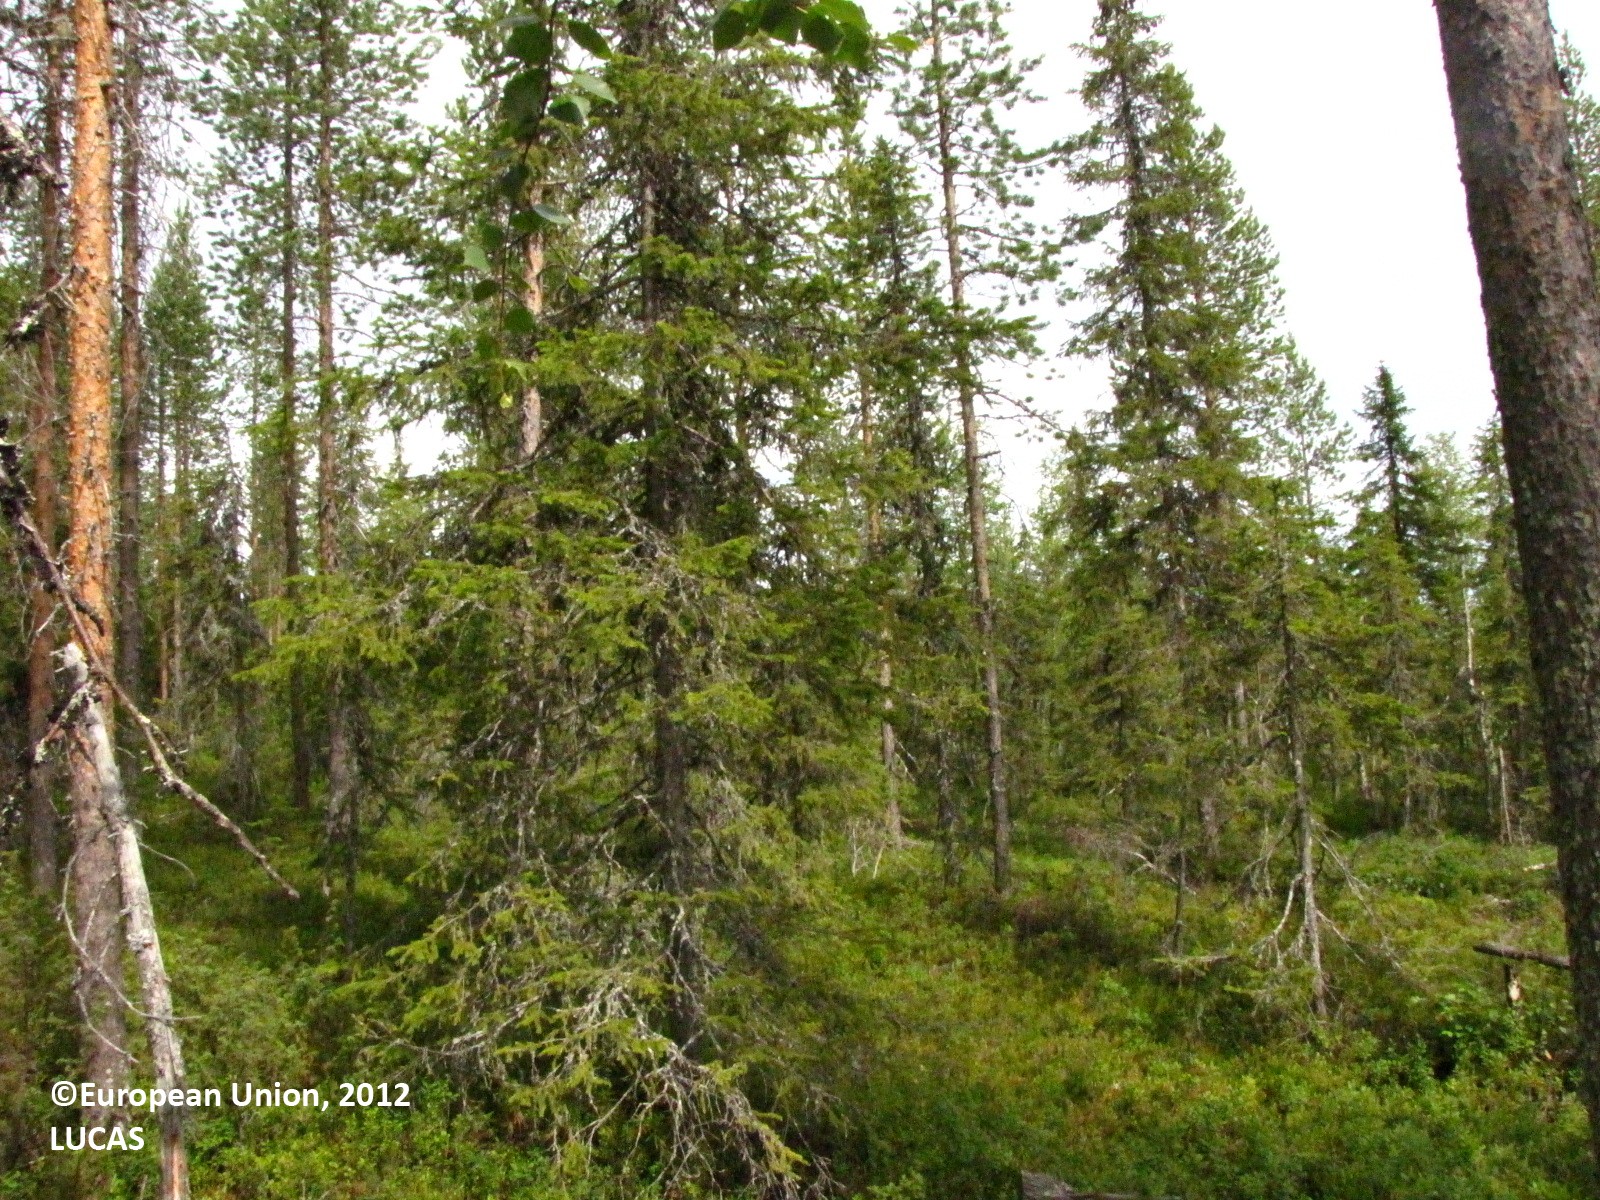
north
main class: Woodland
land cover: Other coniferous woodland
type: boreal forest
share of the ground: 50 - 75 %
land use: Forestry
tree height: > 5 m
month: July
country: FI
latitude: 66.7044
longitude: 25.0759
